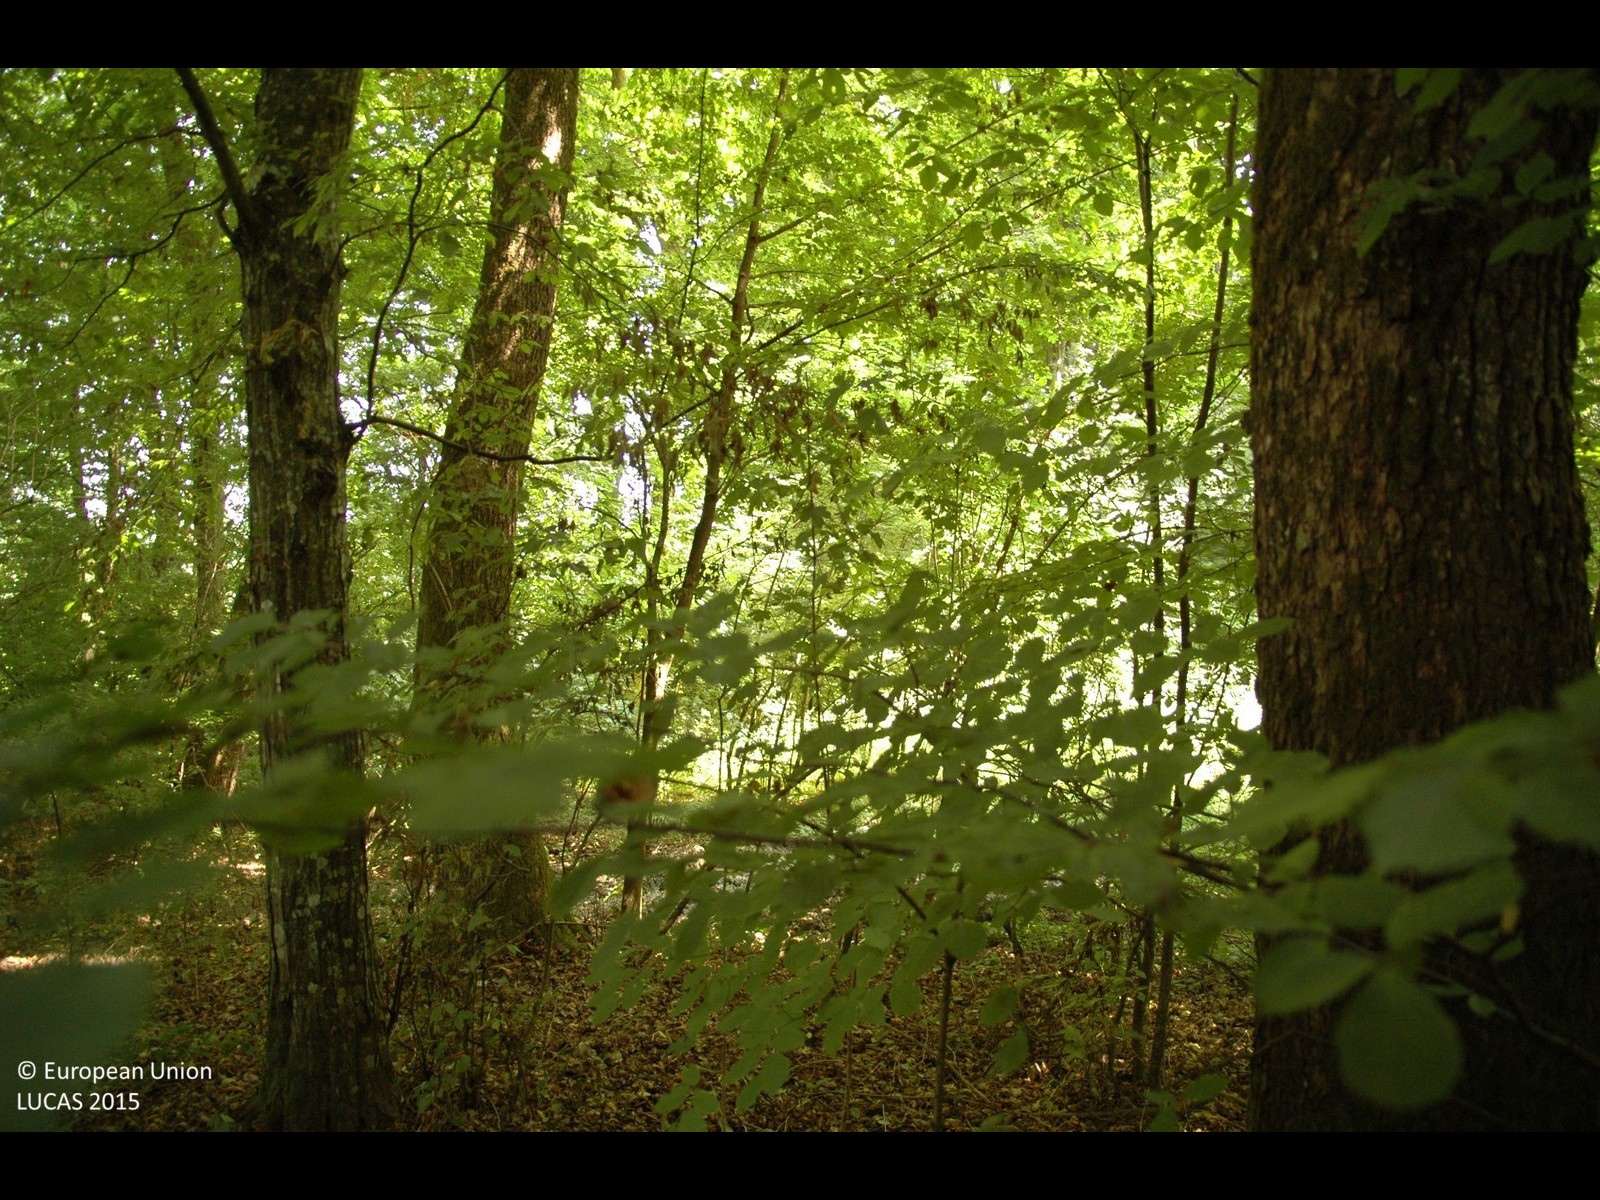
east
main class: Woodland
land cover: Broadleaved woodland
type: mesophytic deciduous forest
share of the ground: > 75 %
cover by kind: broadleaved forest trees 100 %
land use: Forestry
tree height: > 5 m
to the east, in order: Broadleaved woodland; Rivers and streams; Soya; Rivers and streams; Broadleaved woodland
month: July
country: HR
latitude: 46.1626
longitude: 16.6442
